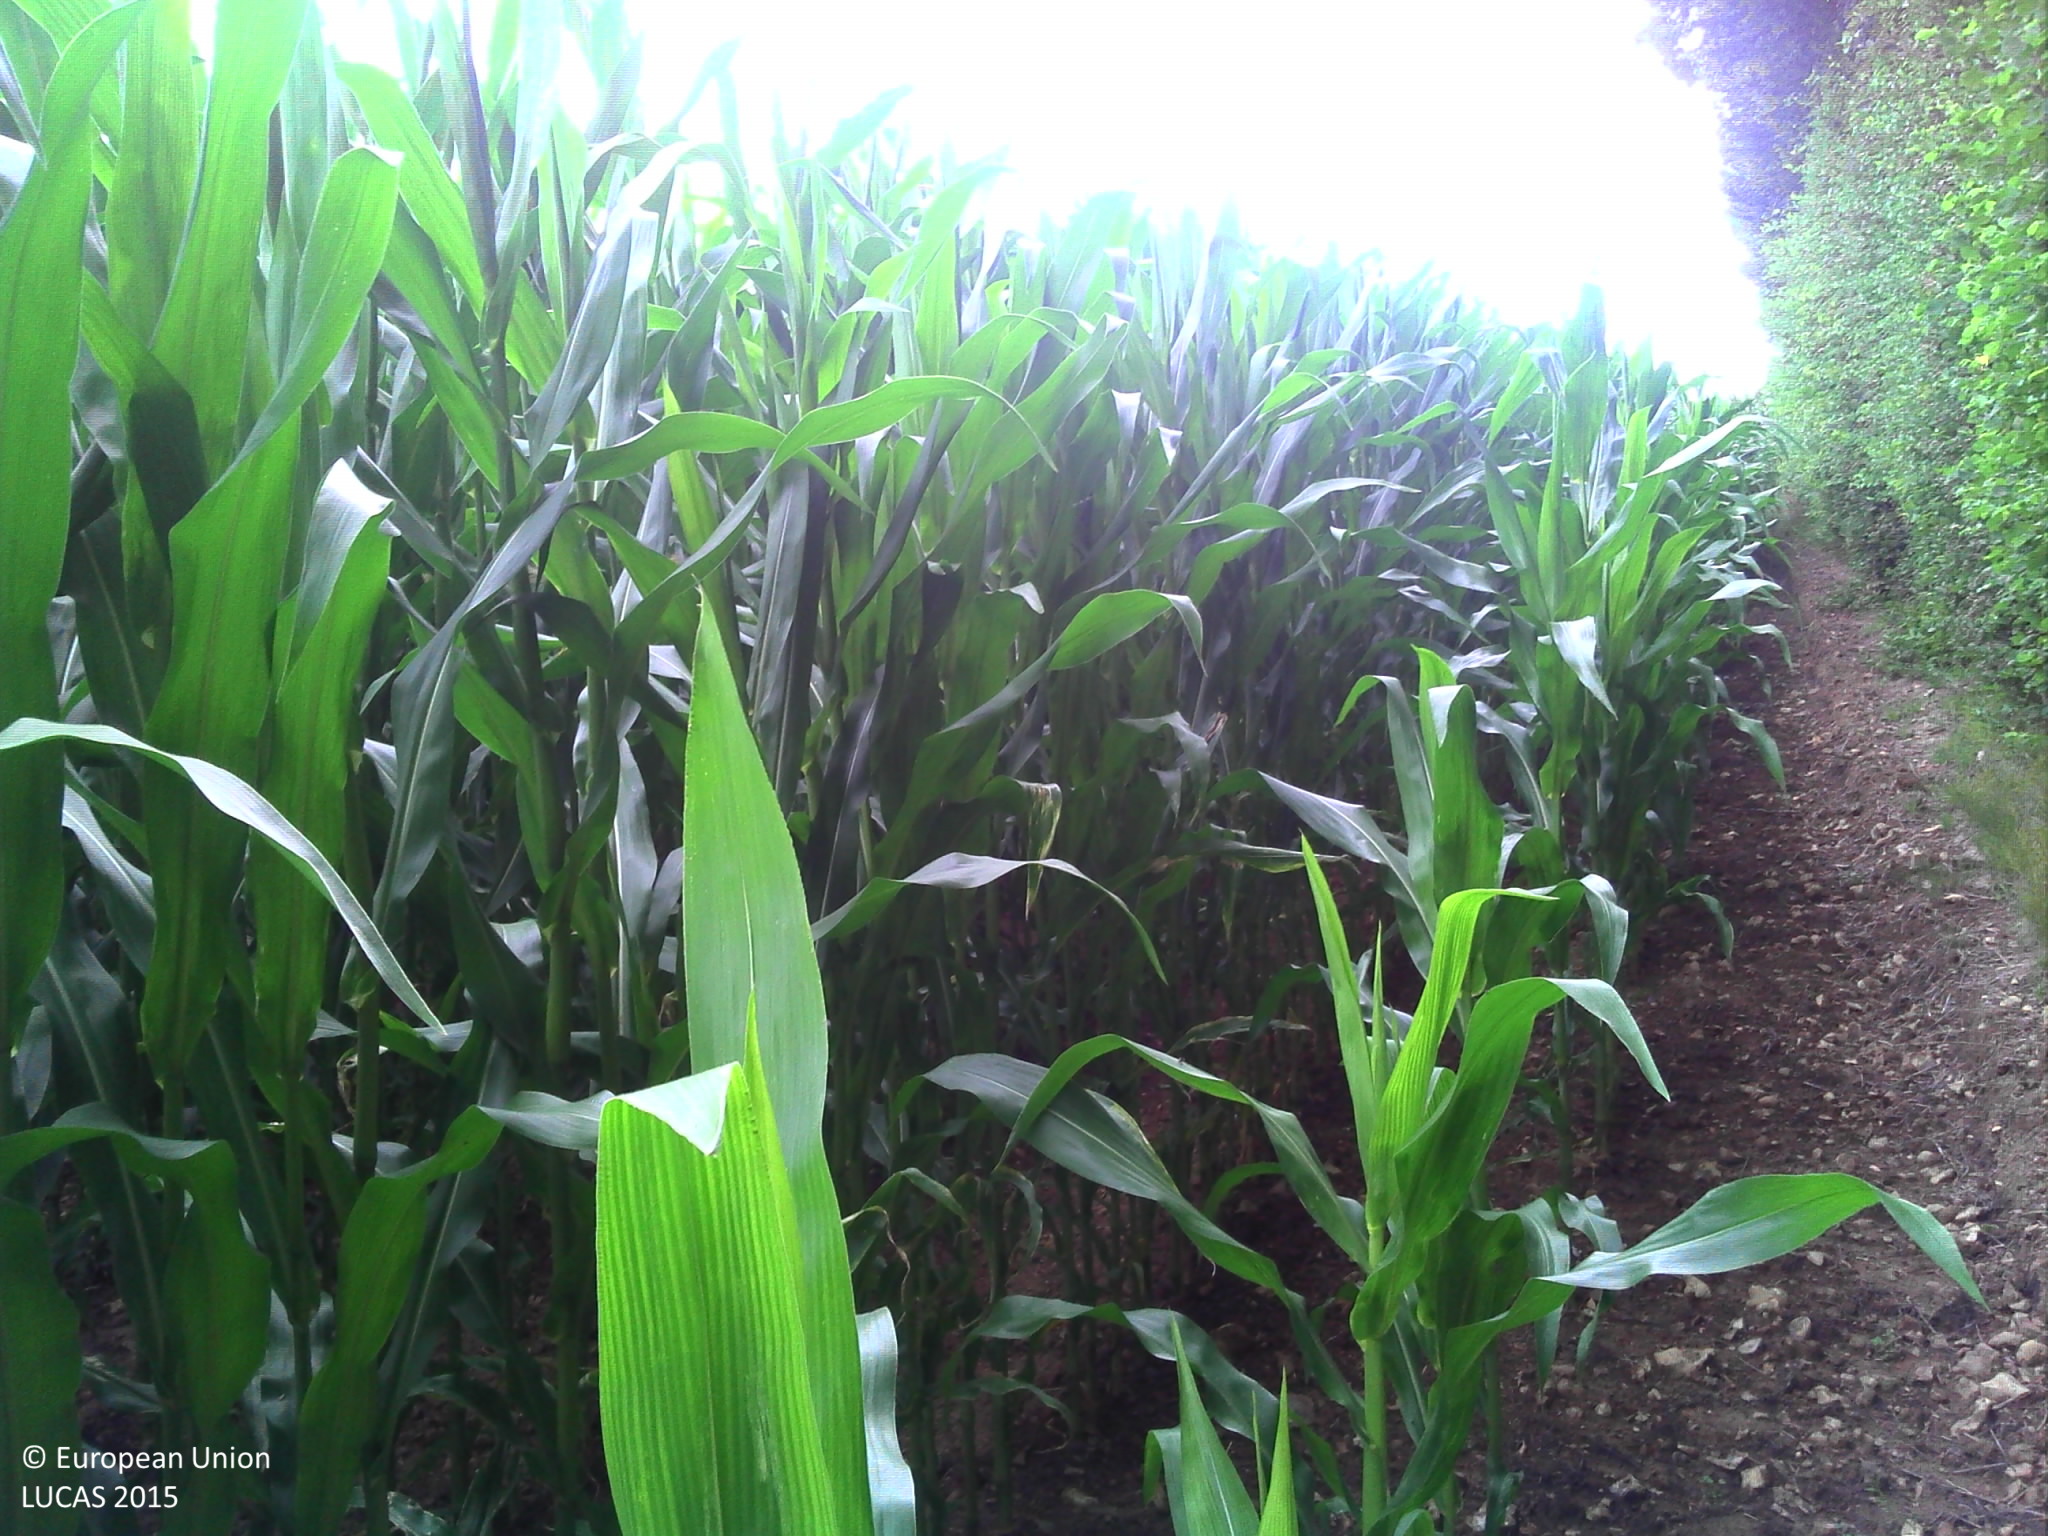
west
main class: Cropland
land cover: Maize
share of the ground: > 75 %
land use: Agriculture (excluding fallow land and kitchen gardens)
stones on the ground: < 10 %
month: July
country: FR
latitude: 48.8562
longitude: 0.4193
